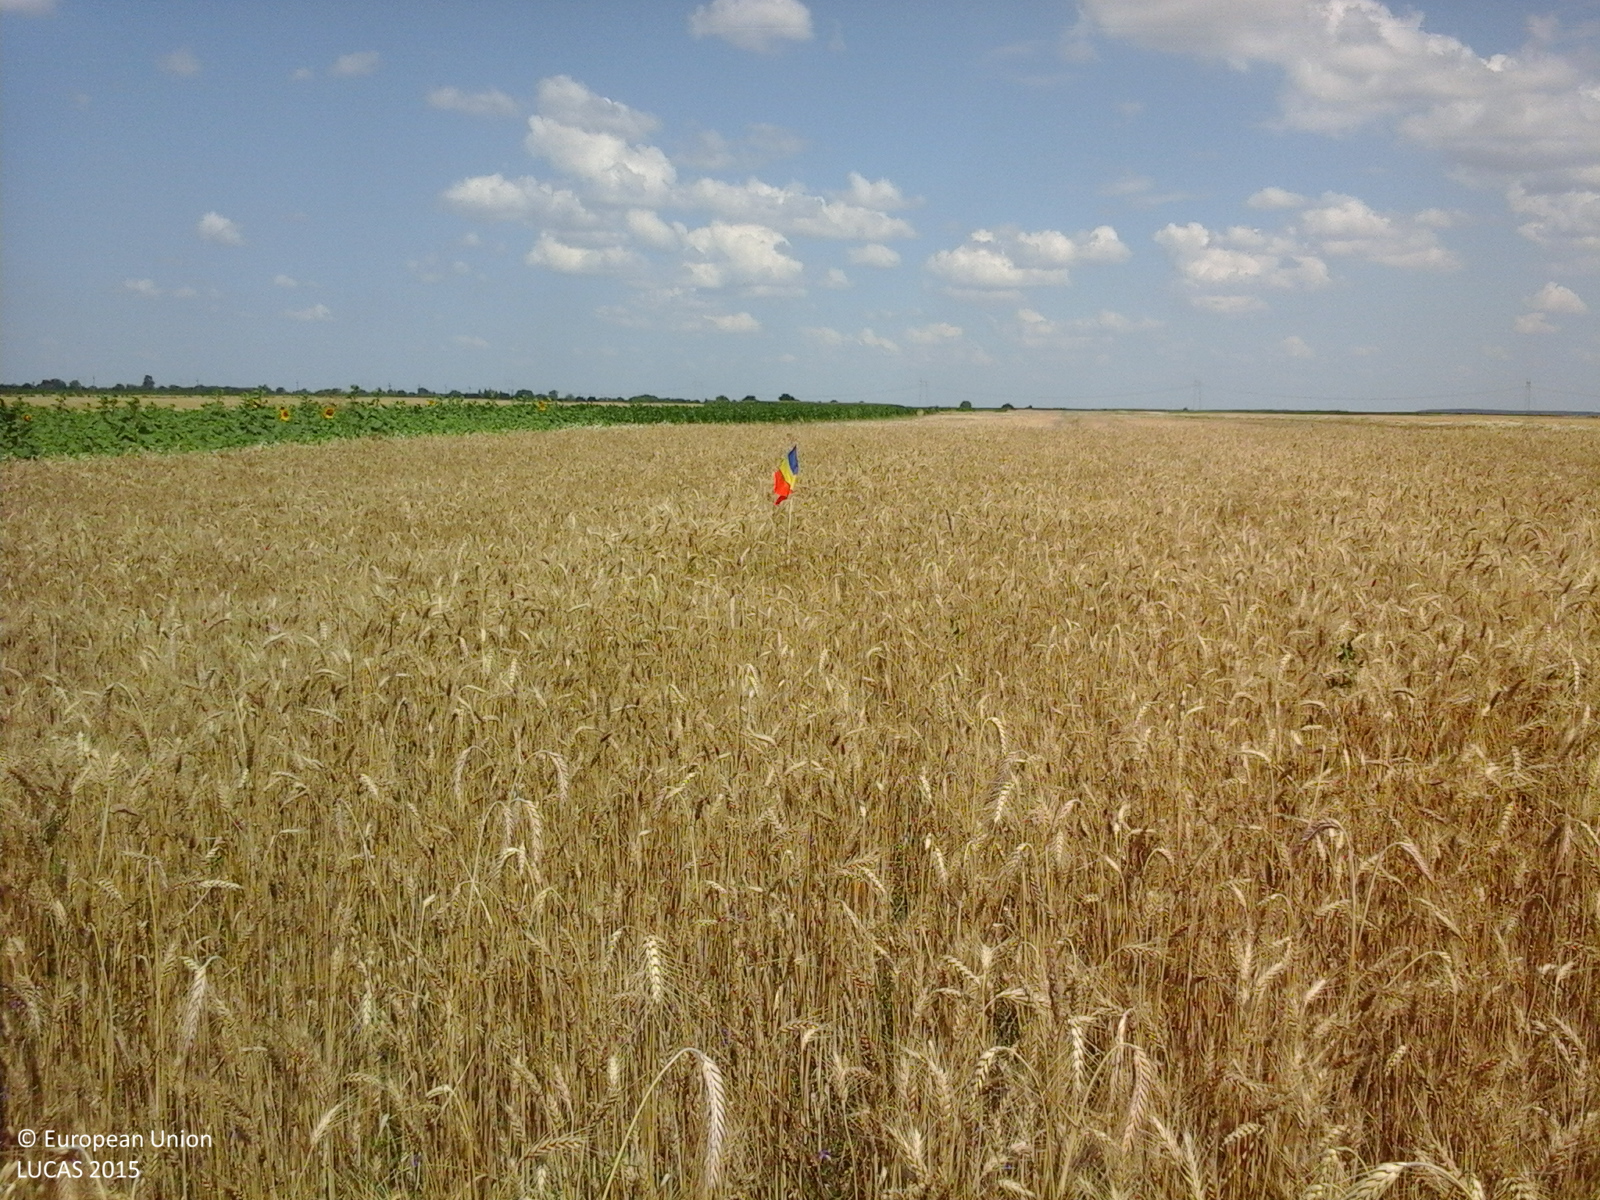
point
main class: Cropland
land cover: Common wheat
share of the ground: > 75 %
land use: Agriculture (excluding fallow land and kitchen gardens)
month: July
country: RO
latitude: 44.2415
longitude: 25.3756
